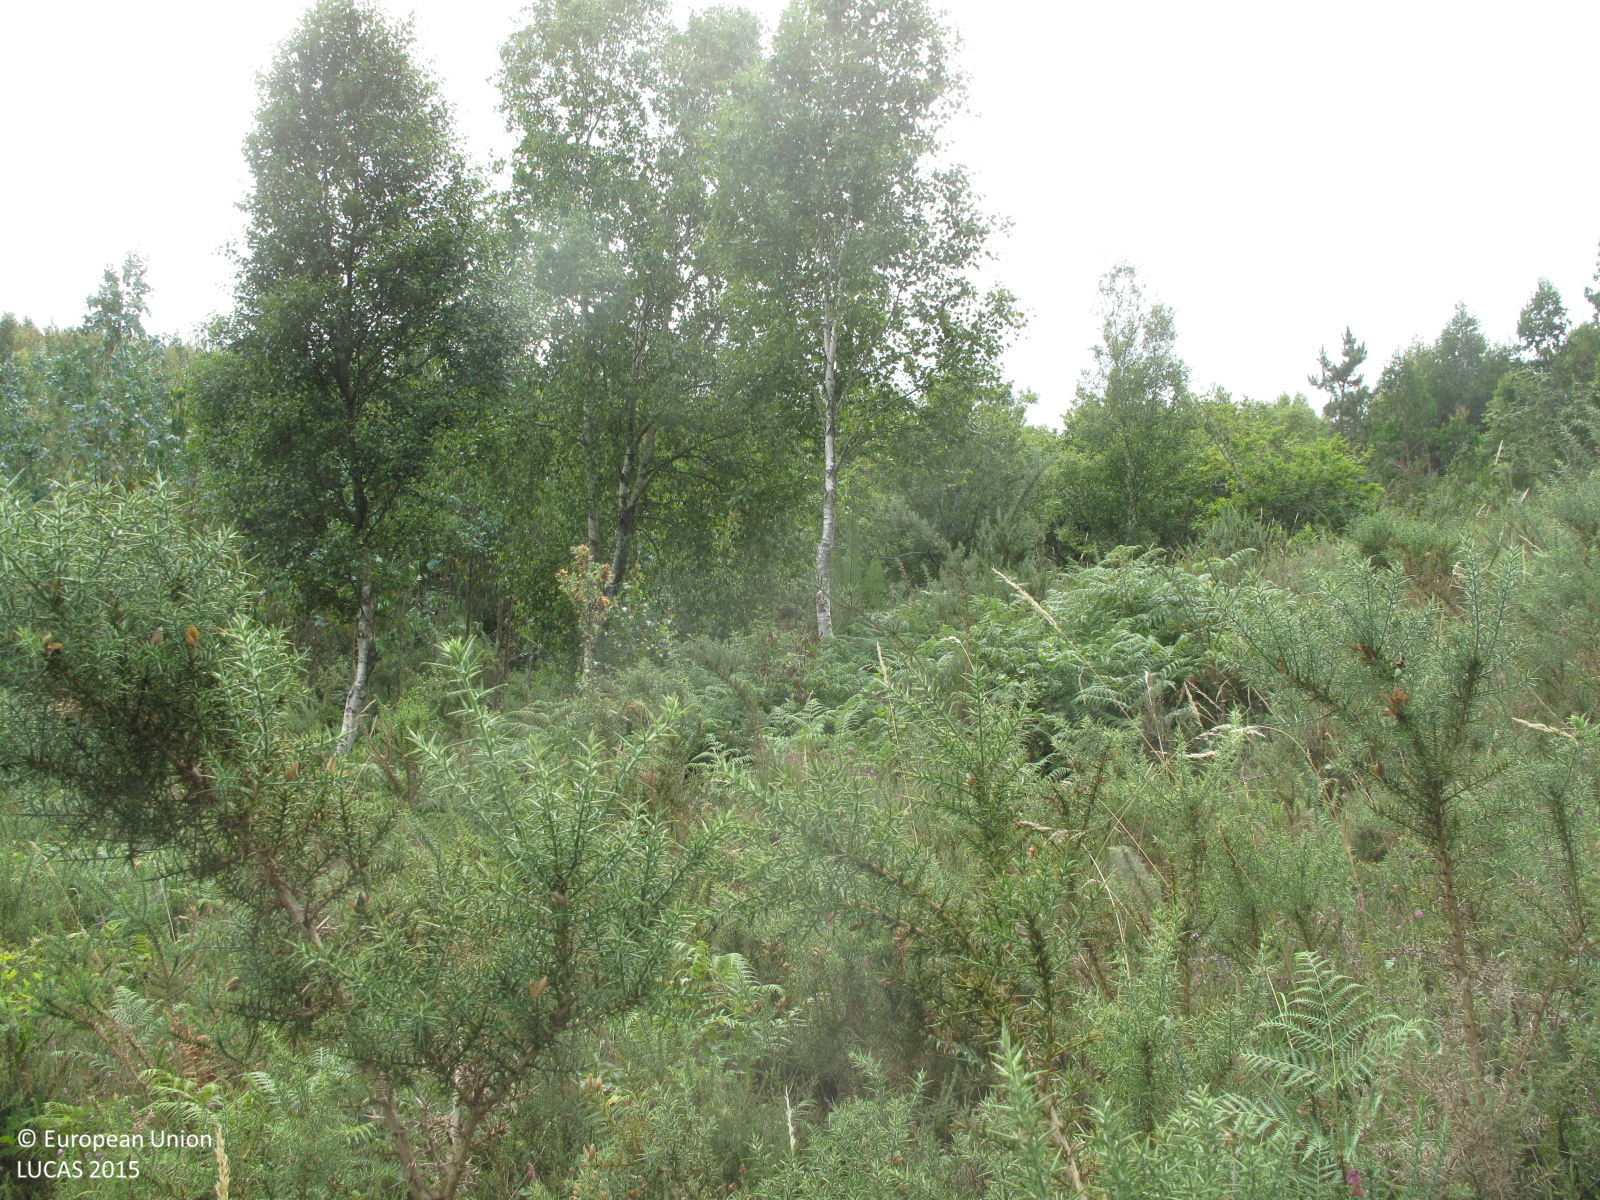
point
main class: Woodland
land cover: Broadleaved woodland
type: acidophilous oak and oak-birch forest
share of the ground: 10 - 25 %
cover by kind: shrubs 80 %, broadleaved forest trees 10 %, herbaceous plants 10 %
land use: Forestry
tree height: > 5 m
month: July
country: ES
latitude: 43.5218
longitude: -8.0750
